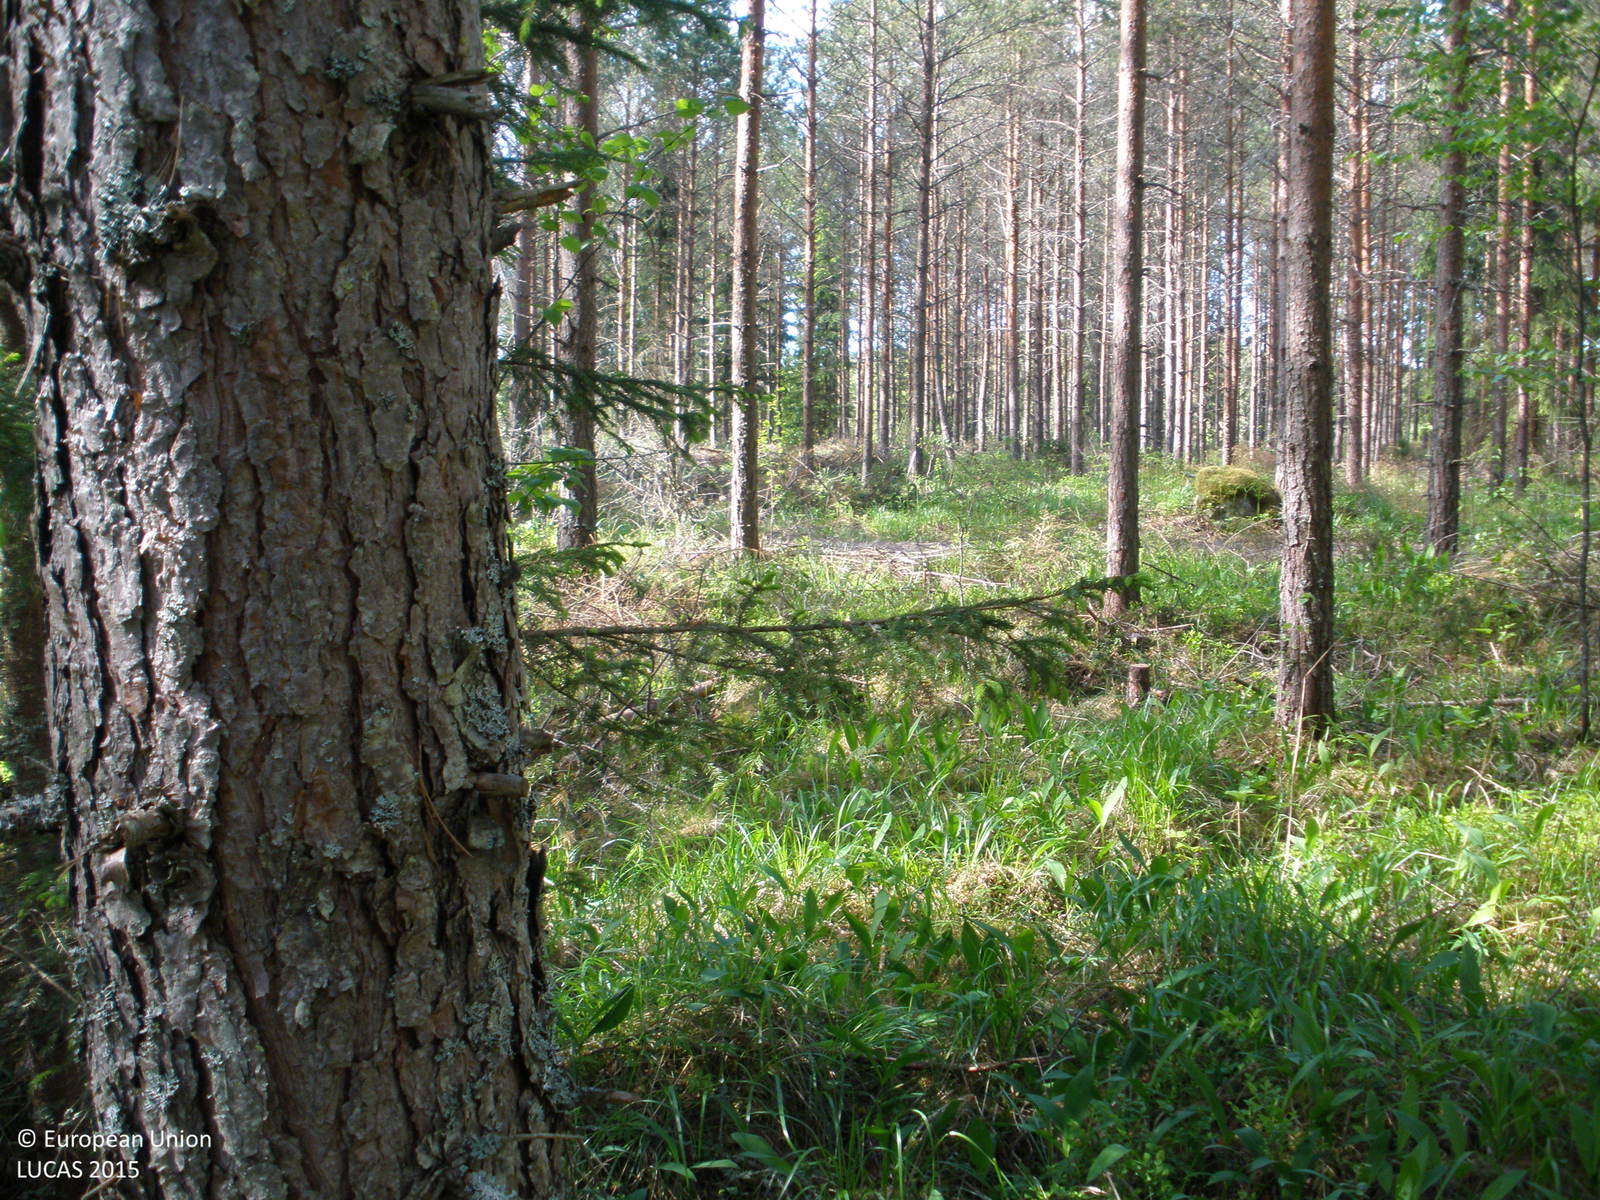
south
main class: Woodland
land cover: Pine dominated coniferous woodland
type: boreal forest
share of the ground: > 75 %
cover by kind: coniferous forest trees 80 %, lichens and mosses 10 %, broadleaved forest trees 5 %, herbaceous plants 5 %
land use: Forestry
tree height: > 5 m
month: June
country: FI
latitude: 60.7585
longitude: 24.0237
